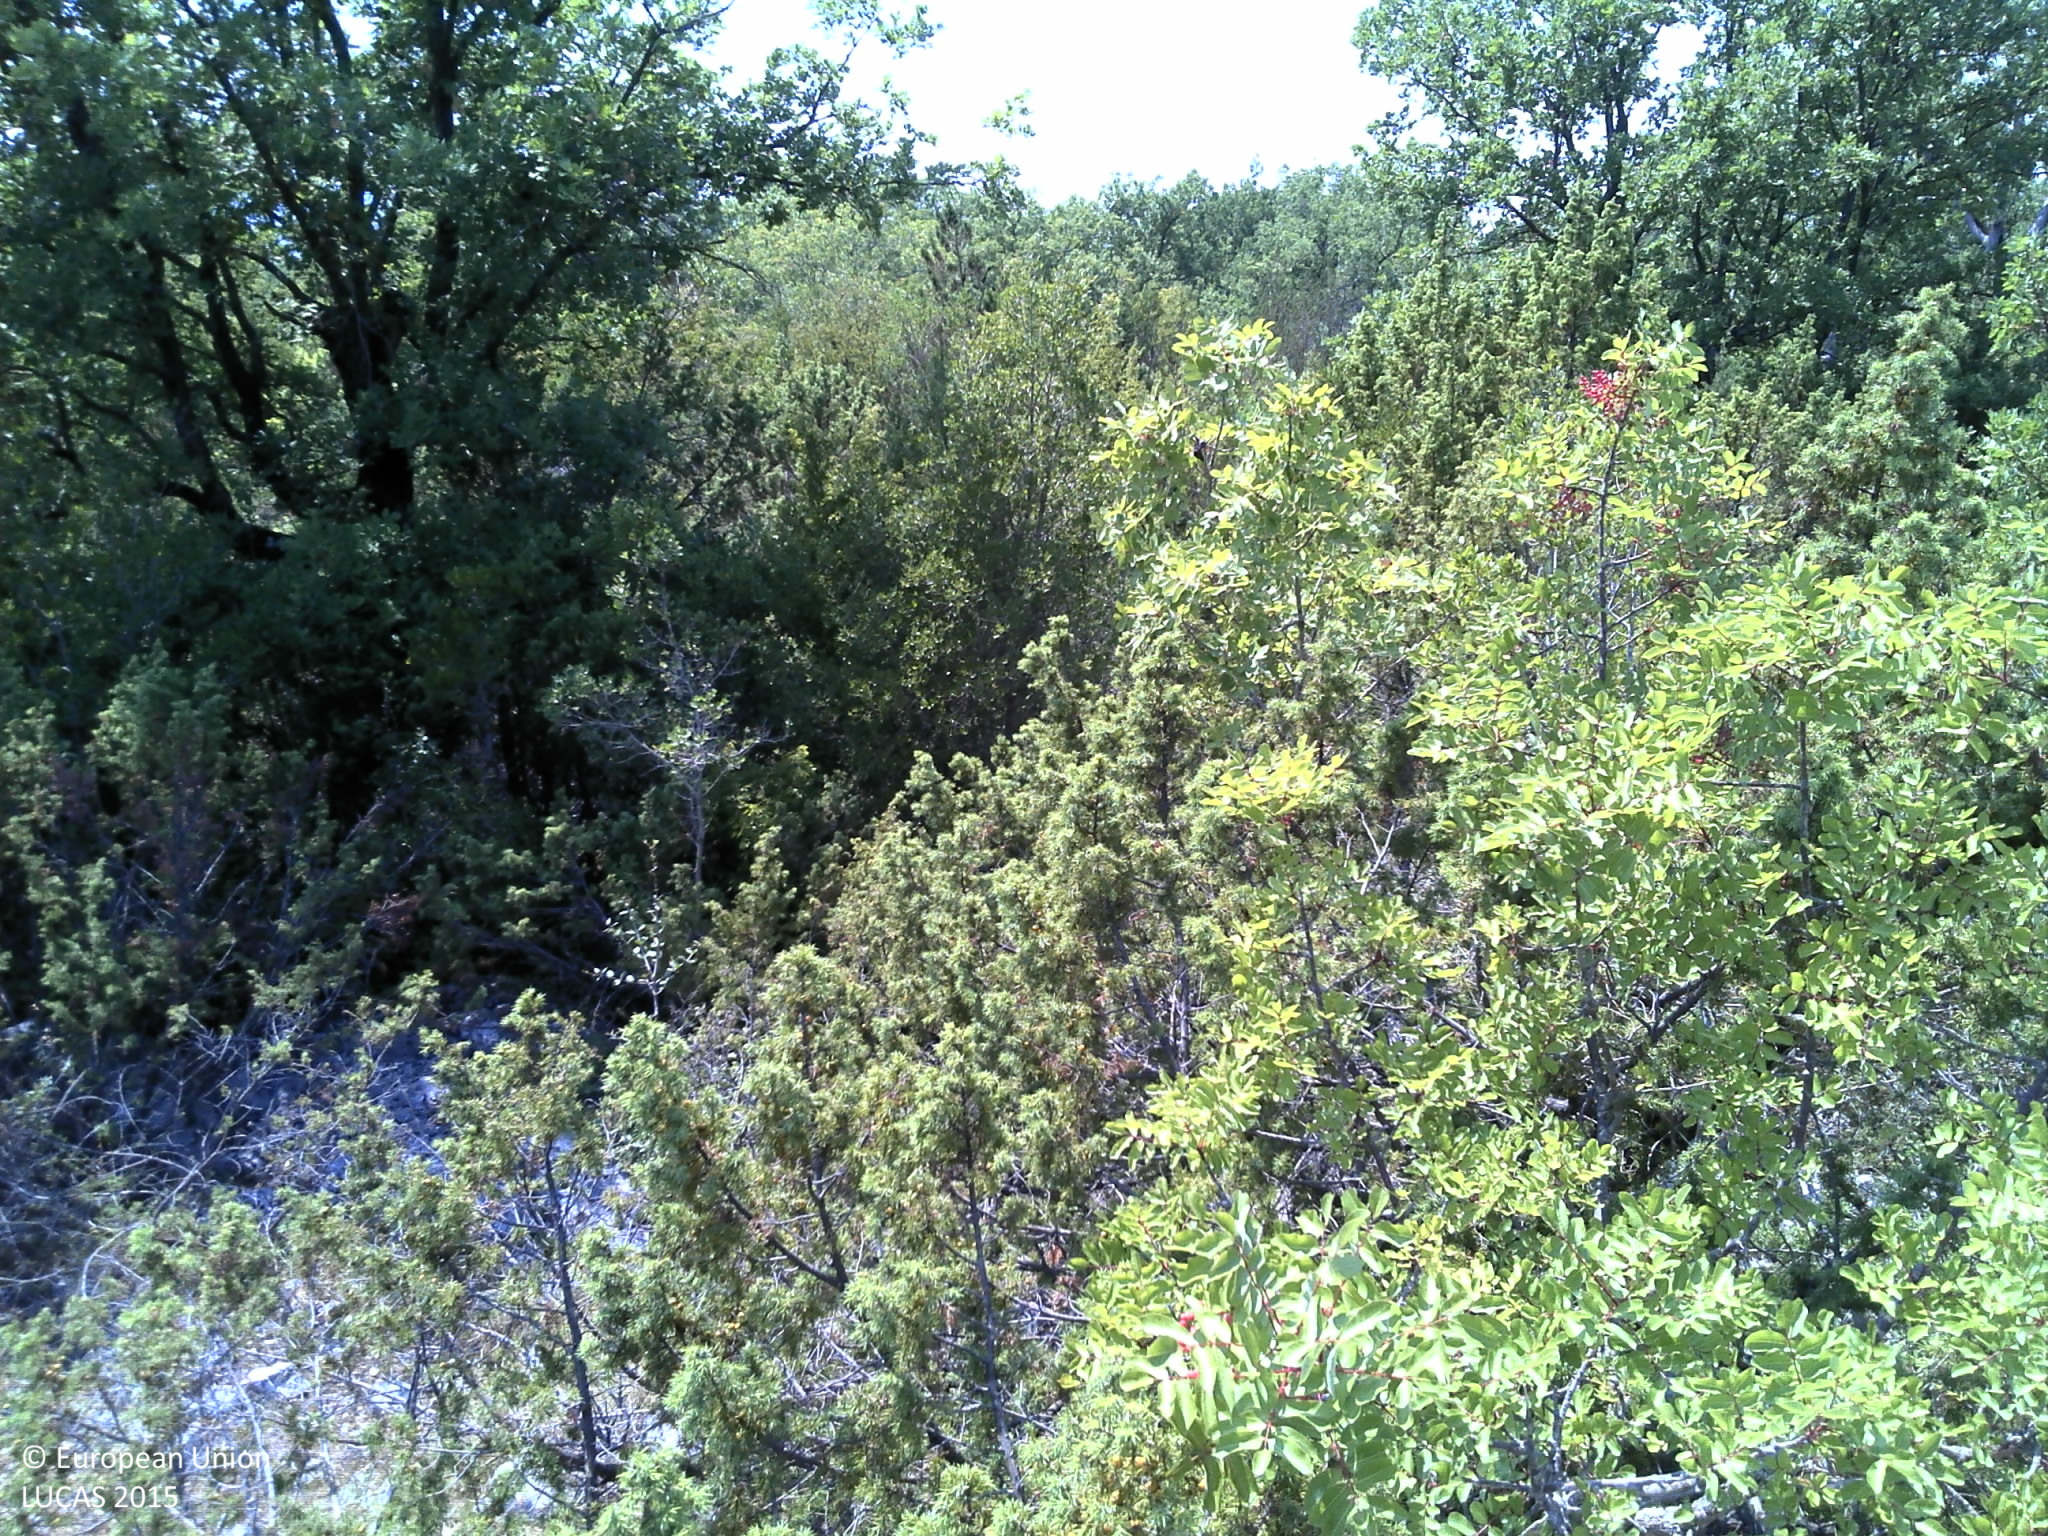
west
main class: Woodland
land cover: Broadleaved woodland
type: thermophilous deciduous forest
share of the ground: 25 - 50 %
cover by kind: broadleaved forest trees 35 %, shrubs 30 %, unconsolidated bare surface 20 %, consolidated bare surface 10 %, coniferous forest trees 5 %
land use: Semi-natural and natural areas not in use
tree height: > 5 m
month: July
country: HR
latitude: 42.9068
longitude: 17.6700
